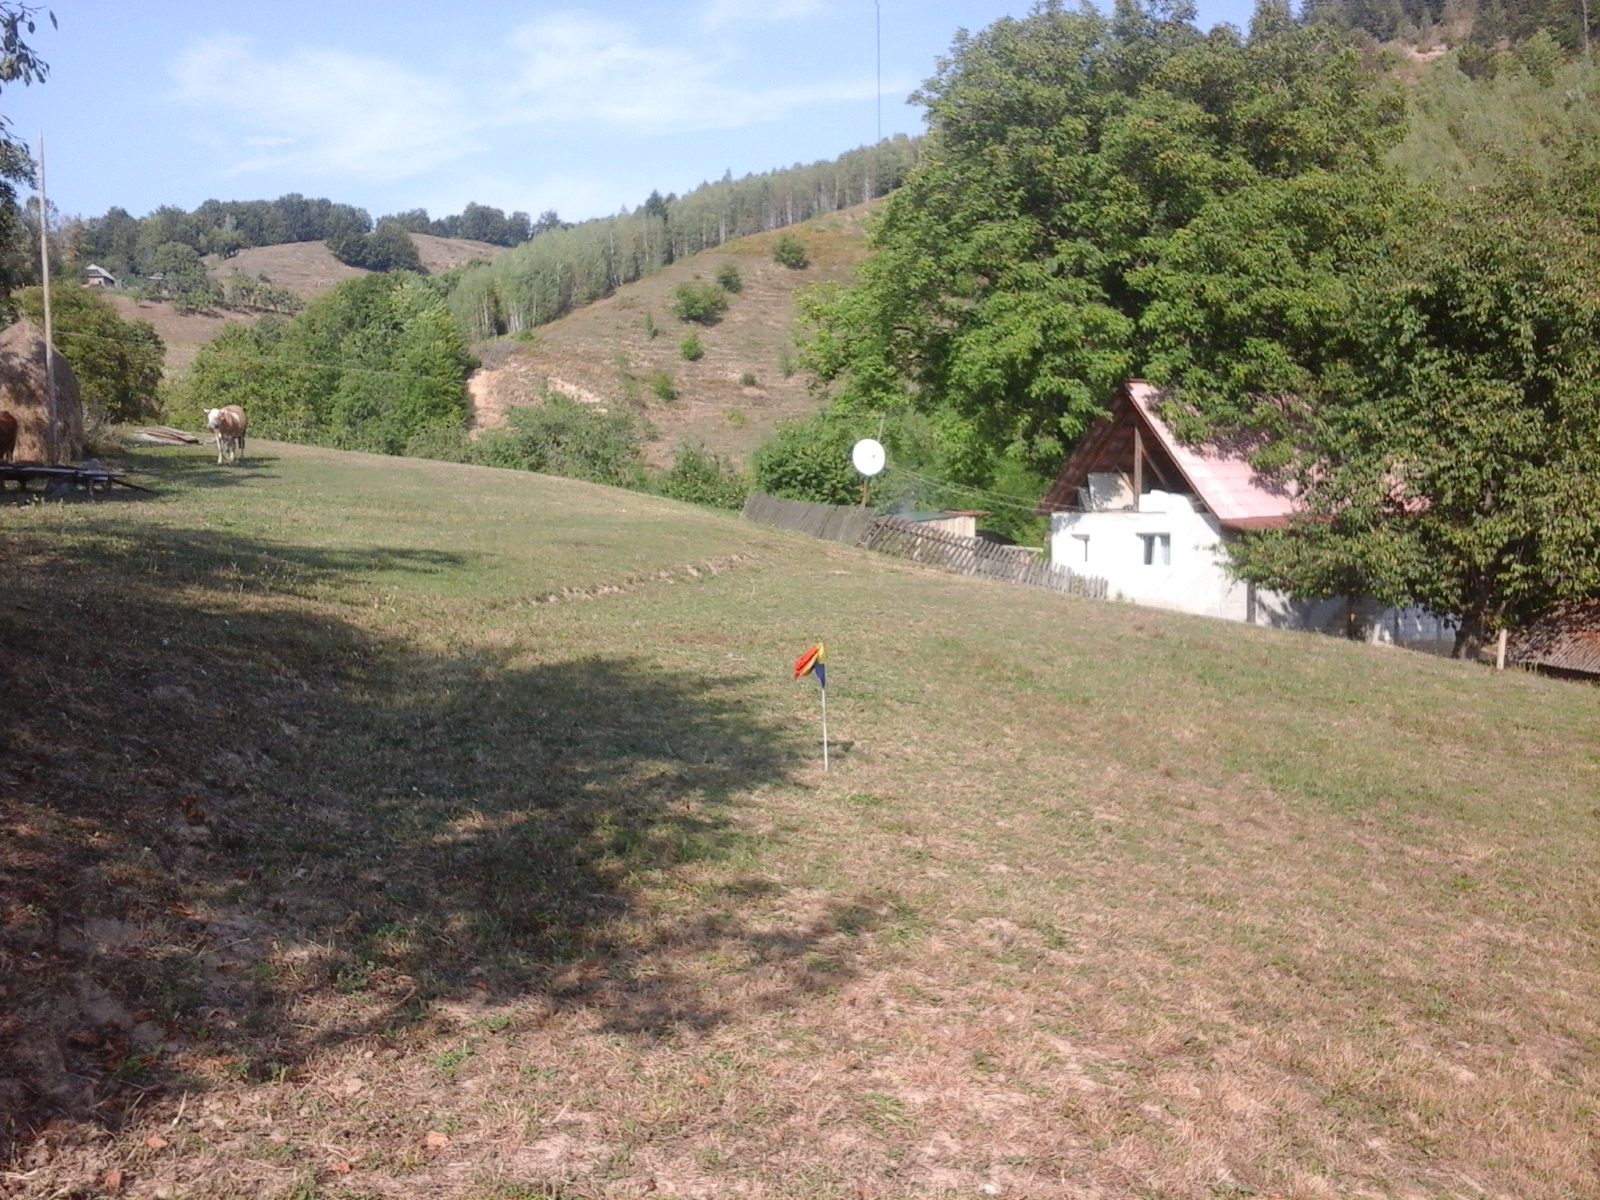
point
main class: Grassland
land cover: Grassland without tree/shrub cover
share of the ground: > 75 %
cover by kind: herbaceous plants 100 %
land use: Agriculture (excluding fallow land and kitchen gardens)
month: September
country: RO
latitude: 47.3904
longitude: 24.1953
